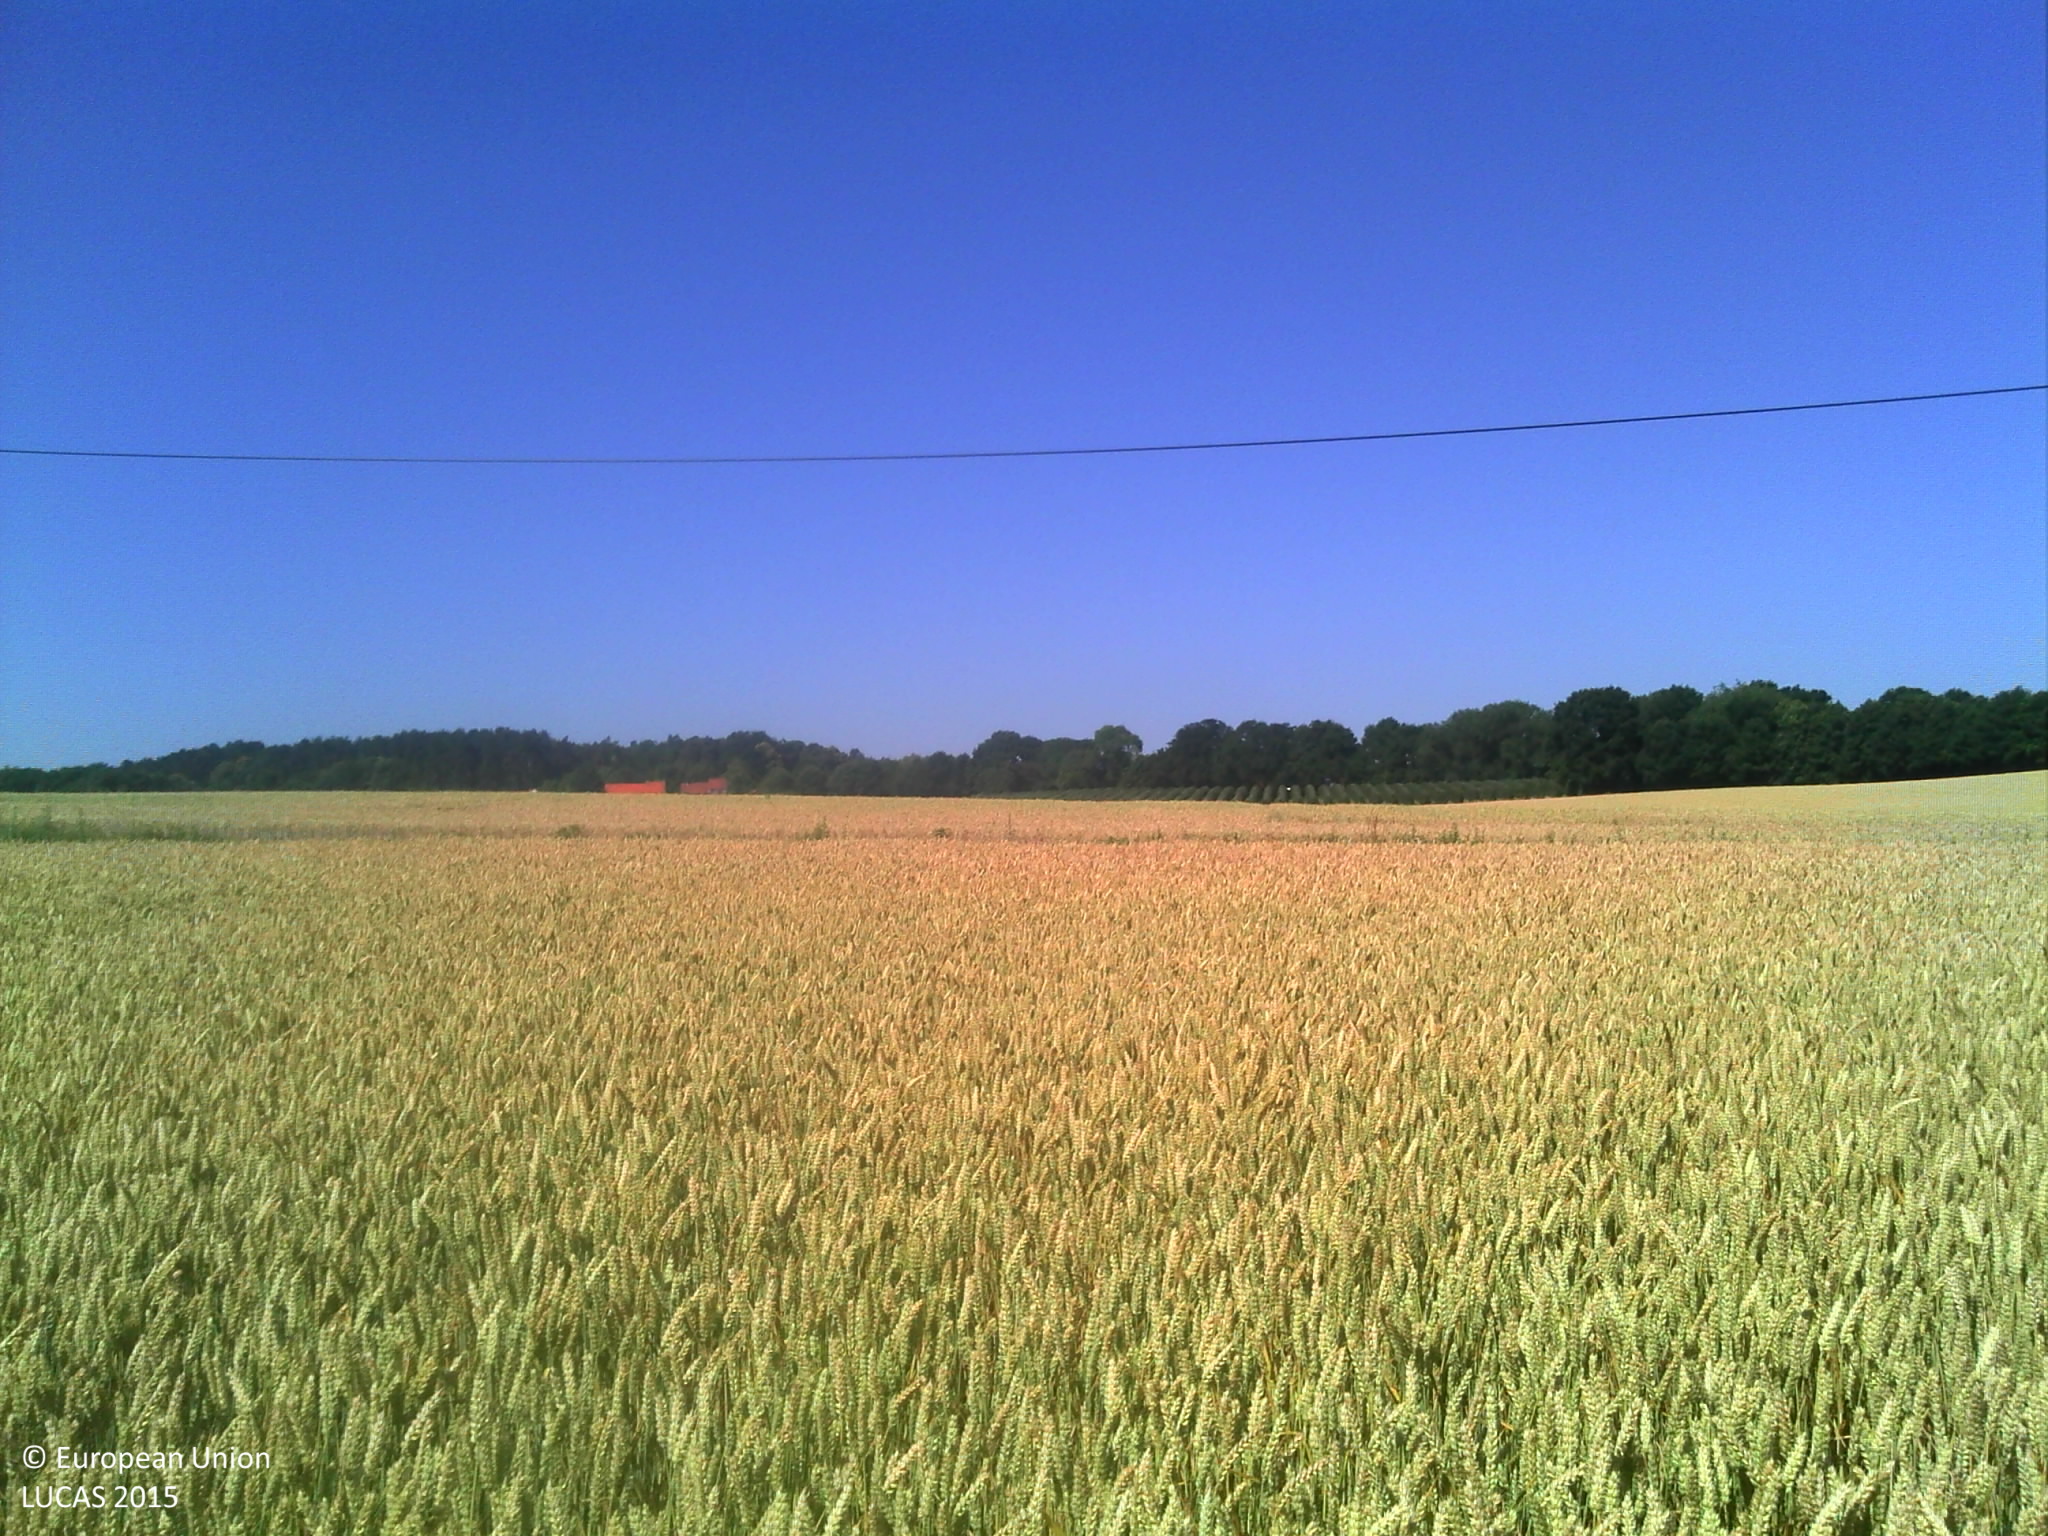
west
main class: Cropland
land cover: Common wheat
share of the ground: > 75 %
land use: Agriculture (excluding fallow land and kitchen gardens)
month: July
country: BE
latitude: 50.8205
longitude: 4.7586
